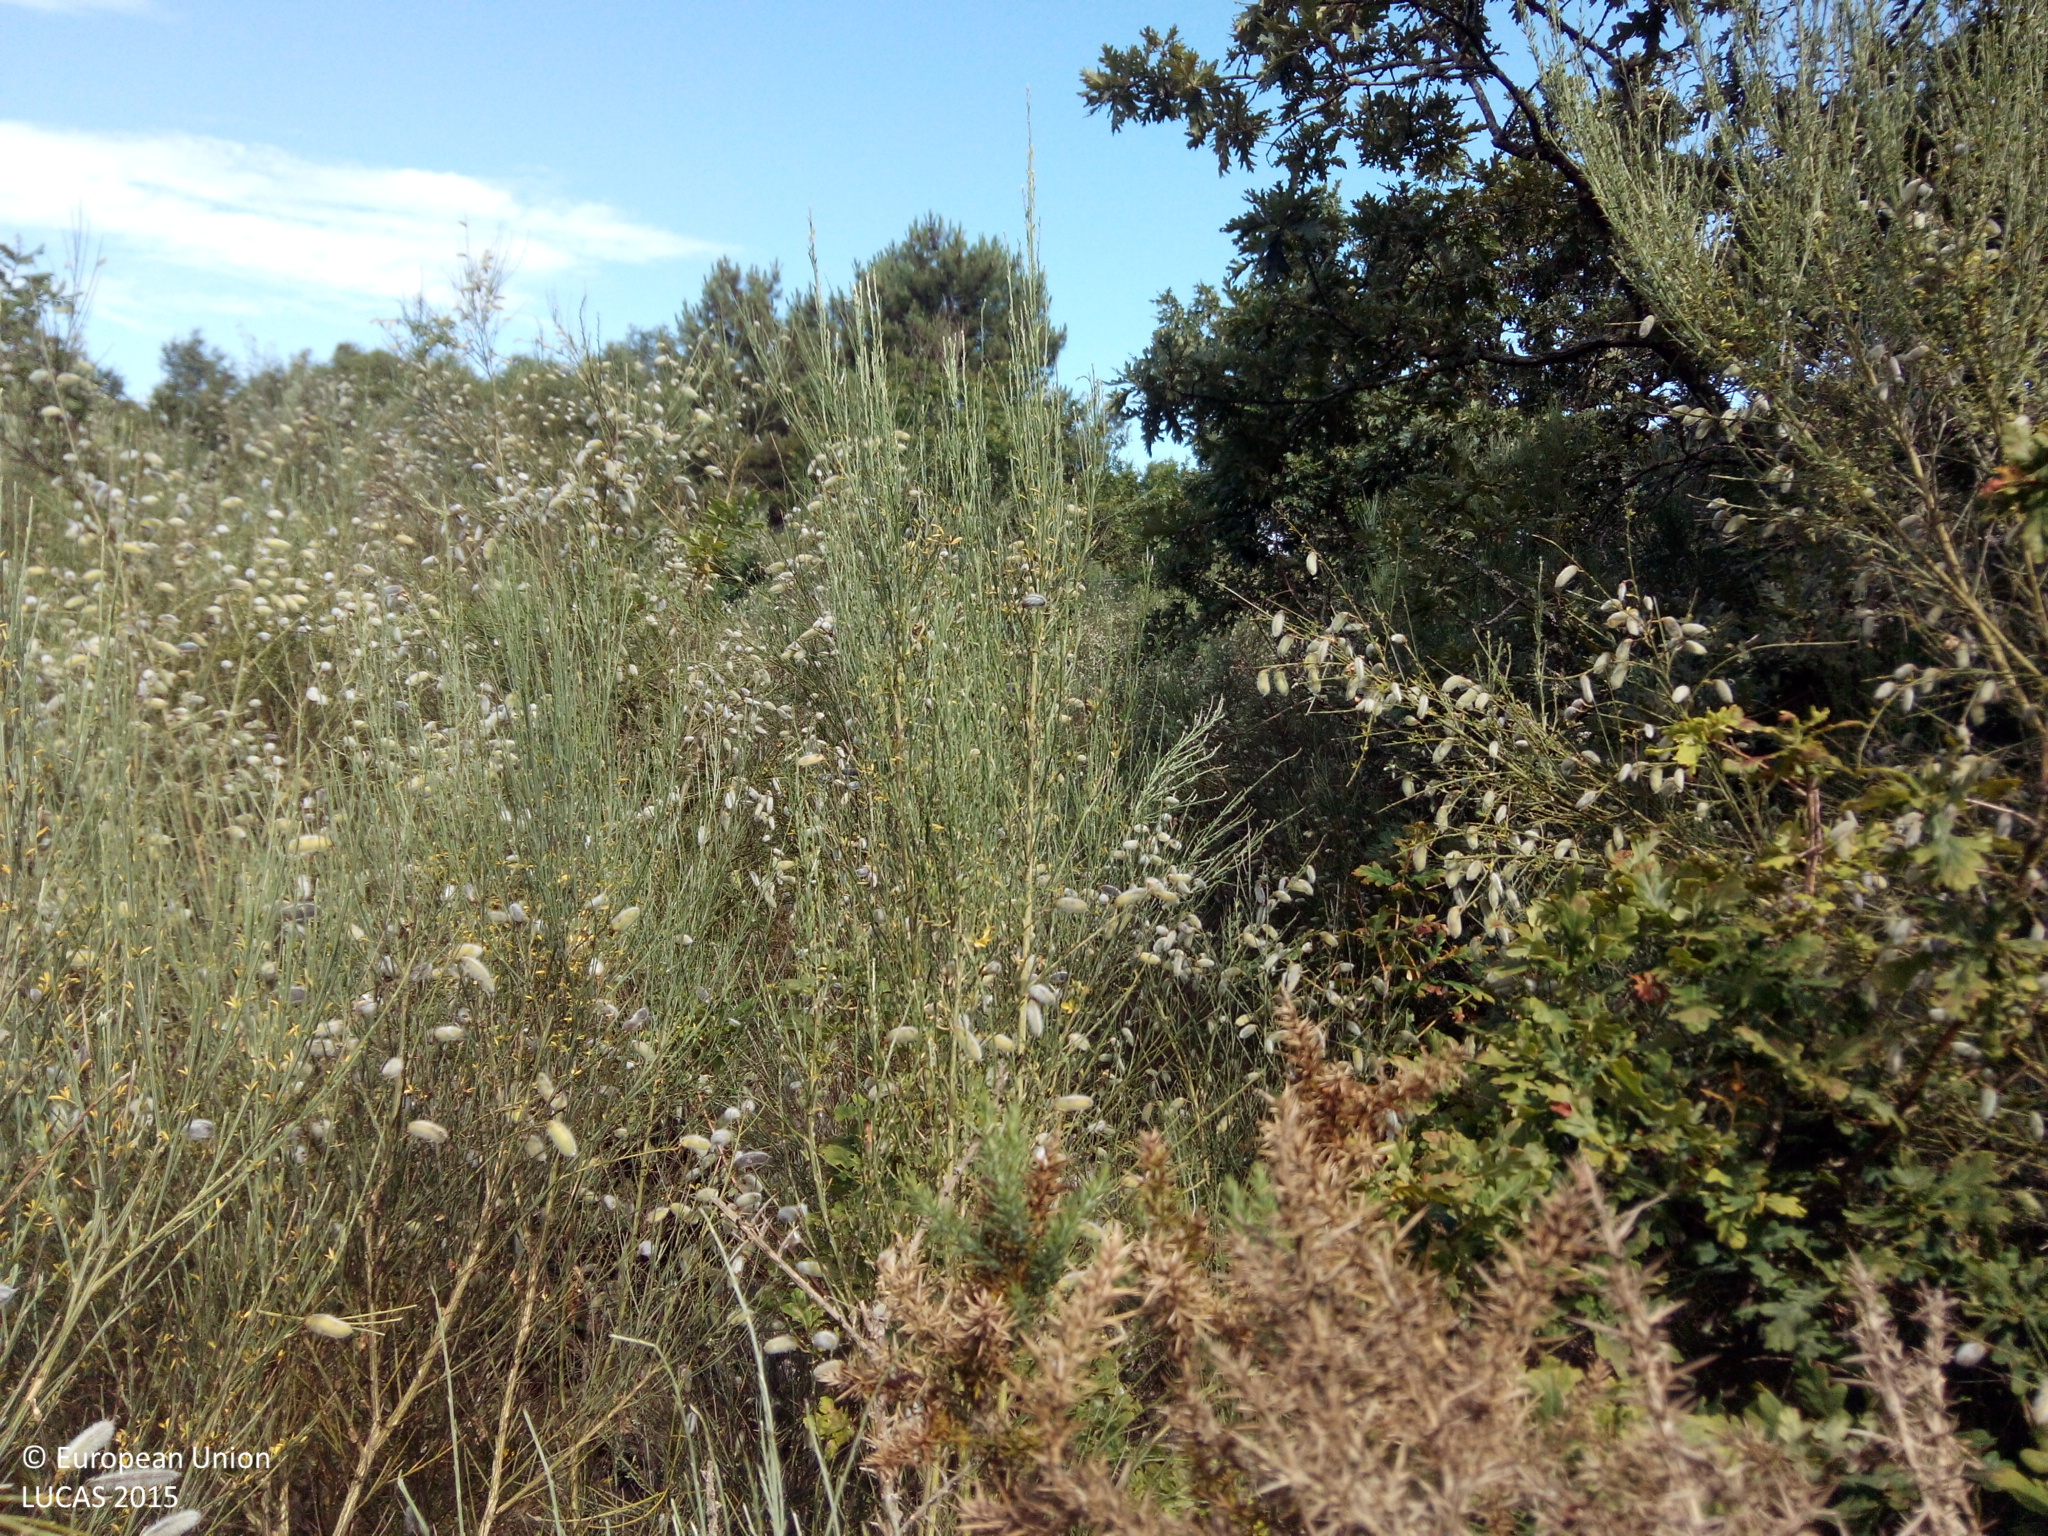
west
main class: Woodland
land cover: Other mixed woodland
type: acidophilous oak and oak-birch forest
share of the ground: > 75 %
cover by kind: shrubs 75 %, broadleaved forest trees 15 %, coniferous forest trees 10 %
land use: Abandoned areas
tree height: > 5 m
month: July
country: ES
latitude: 42.3615
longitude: -8.2653
